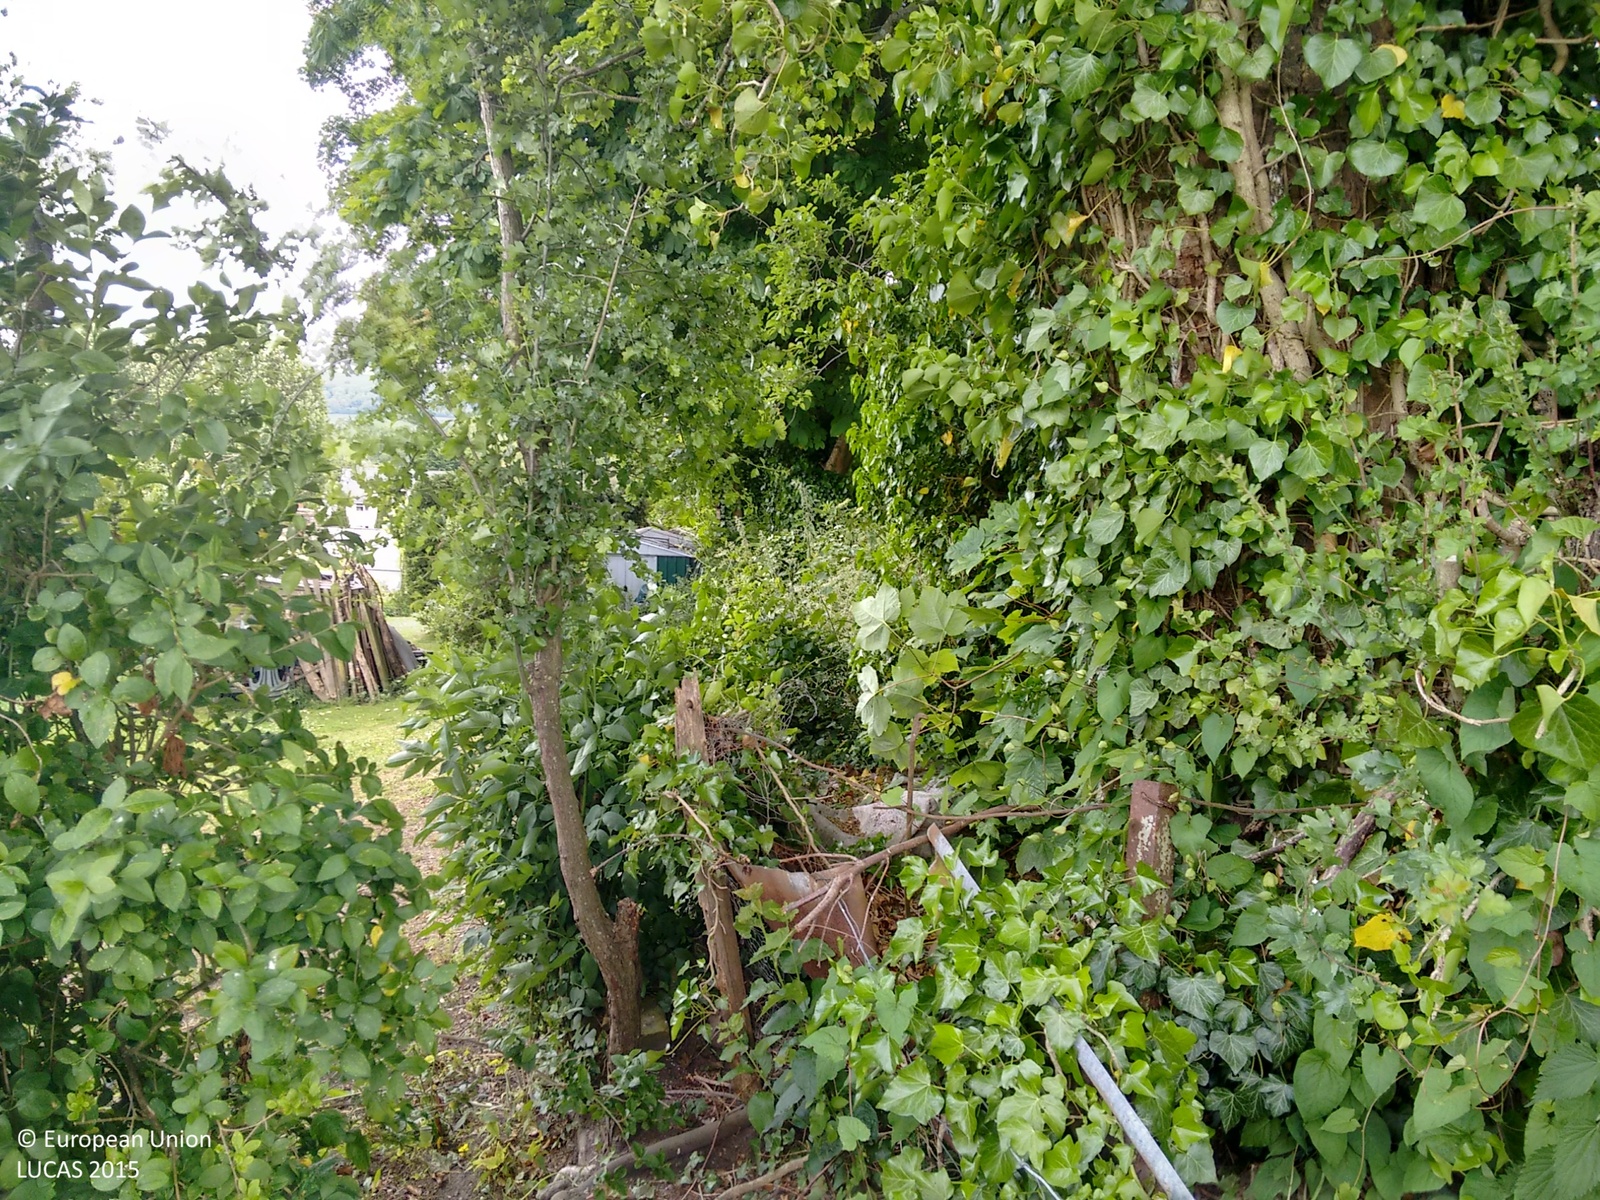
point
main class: Woodland
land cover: Broadleaved woodland
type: mesophytic deciduous forest
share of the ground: > 75 %
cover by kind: broadleaved forest trees 100 %
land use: Residential
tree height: > 5 m
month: June
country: GB
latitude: 51.0834
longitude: -1.9200
